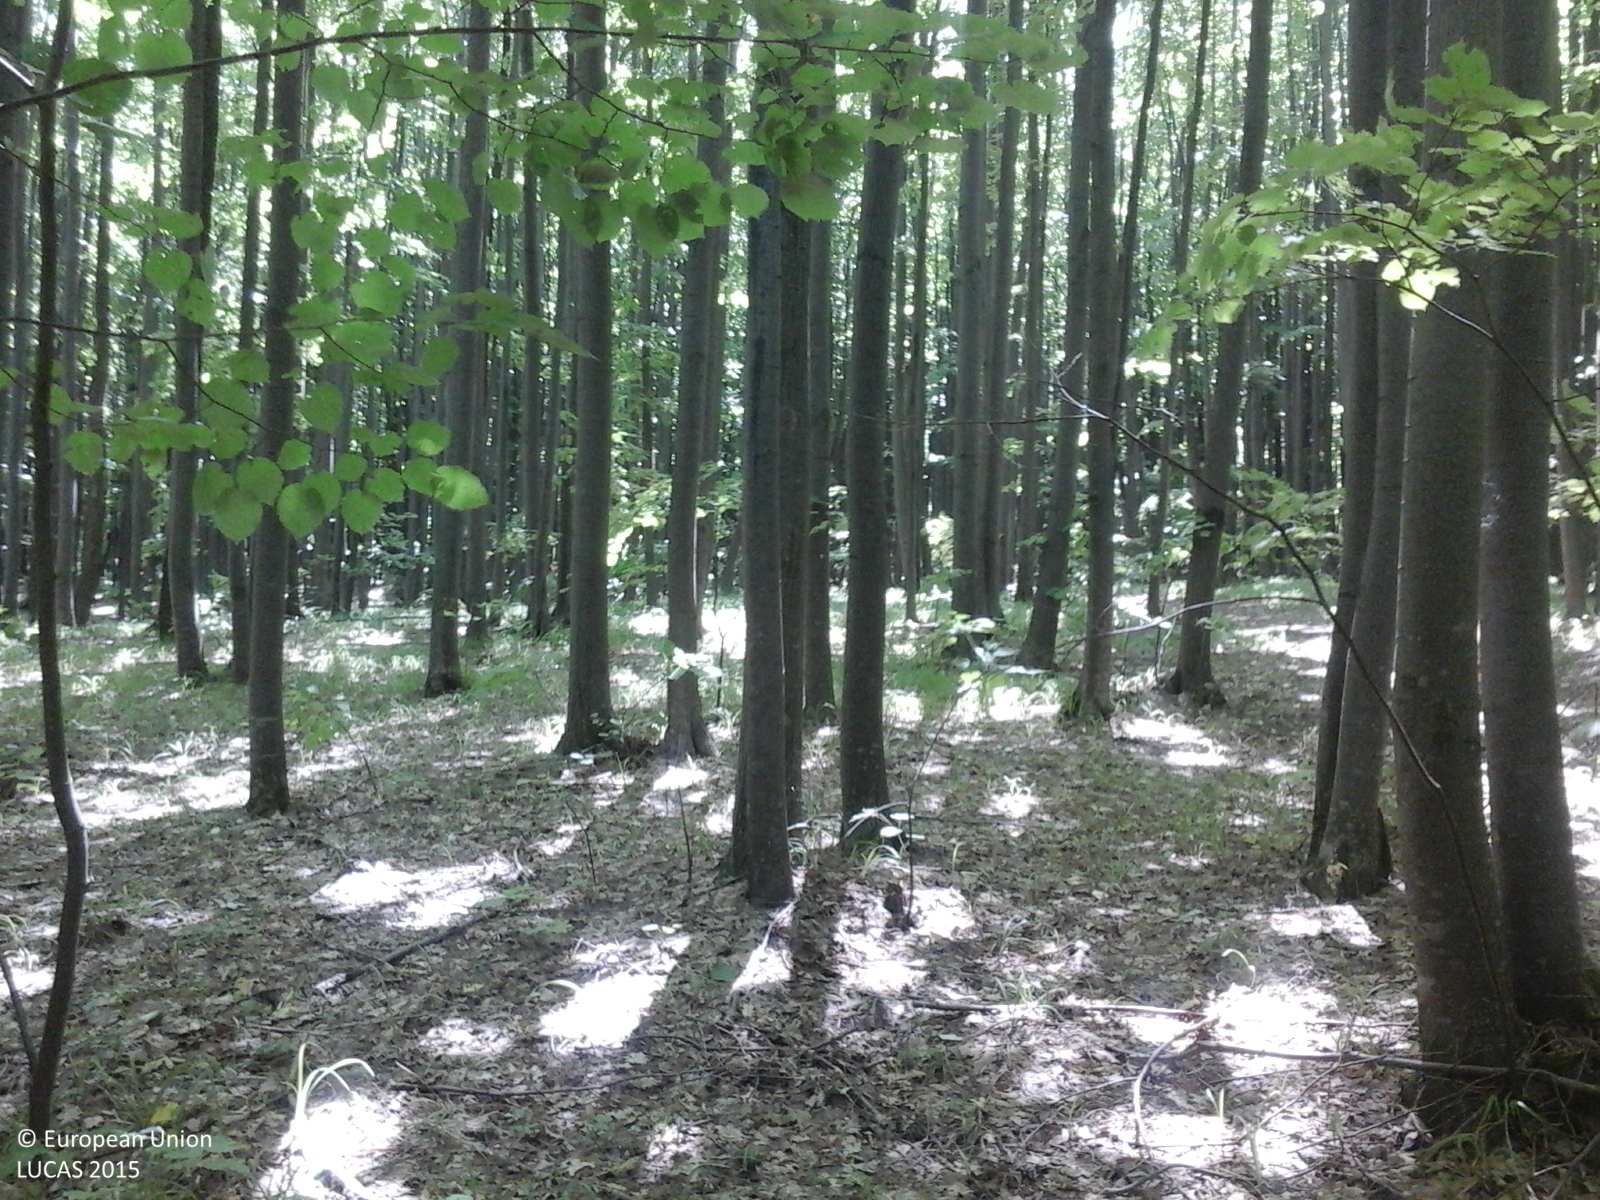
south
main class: Woodland
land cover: Broadleaved woodland
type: beech forest
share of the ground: > 75 %
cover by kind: broadleaved forest trees 95 %, herbaceous plants 5 %
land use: Forestry
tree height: > 5 m
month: June
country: RO
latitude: 45.0447
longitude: 26.1209
